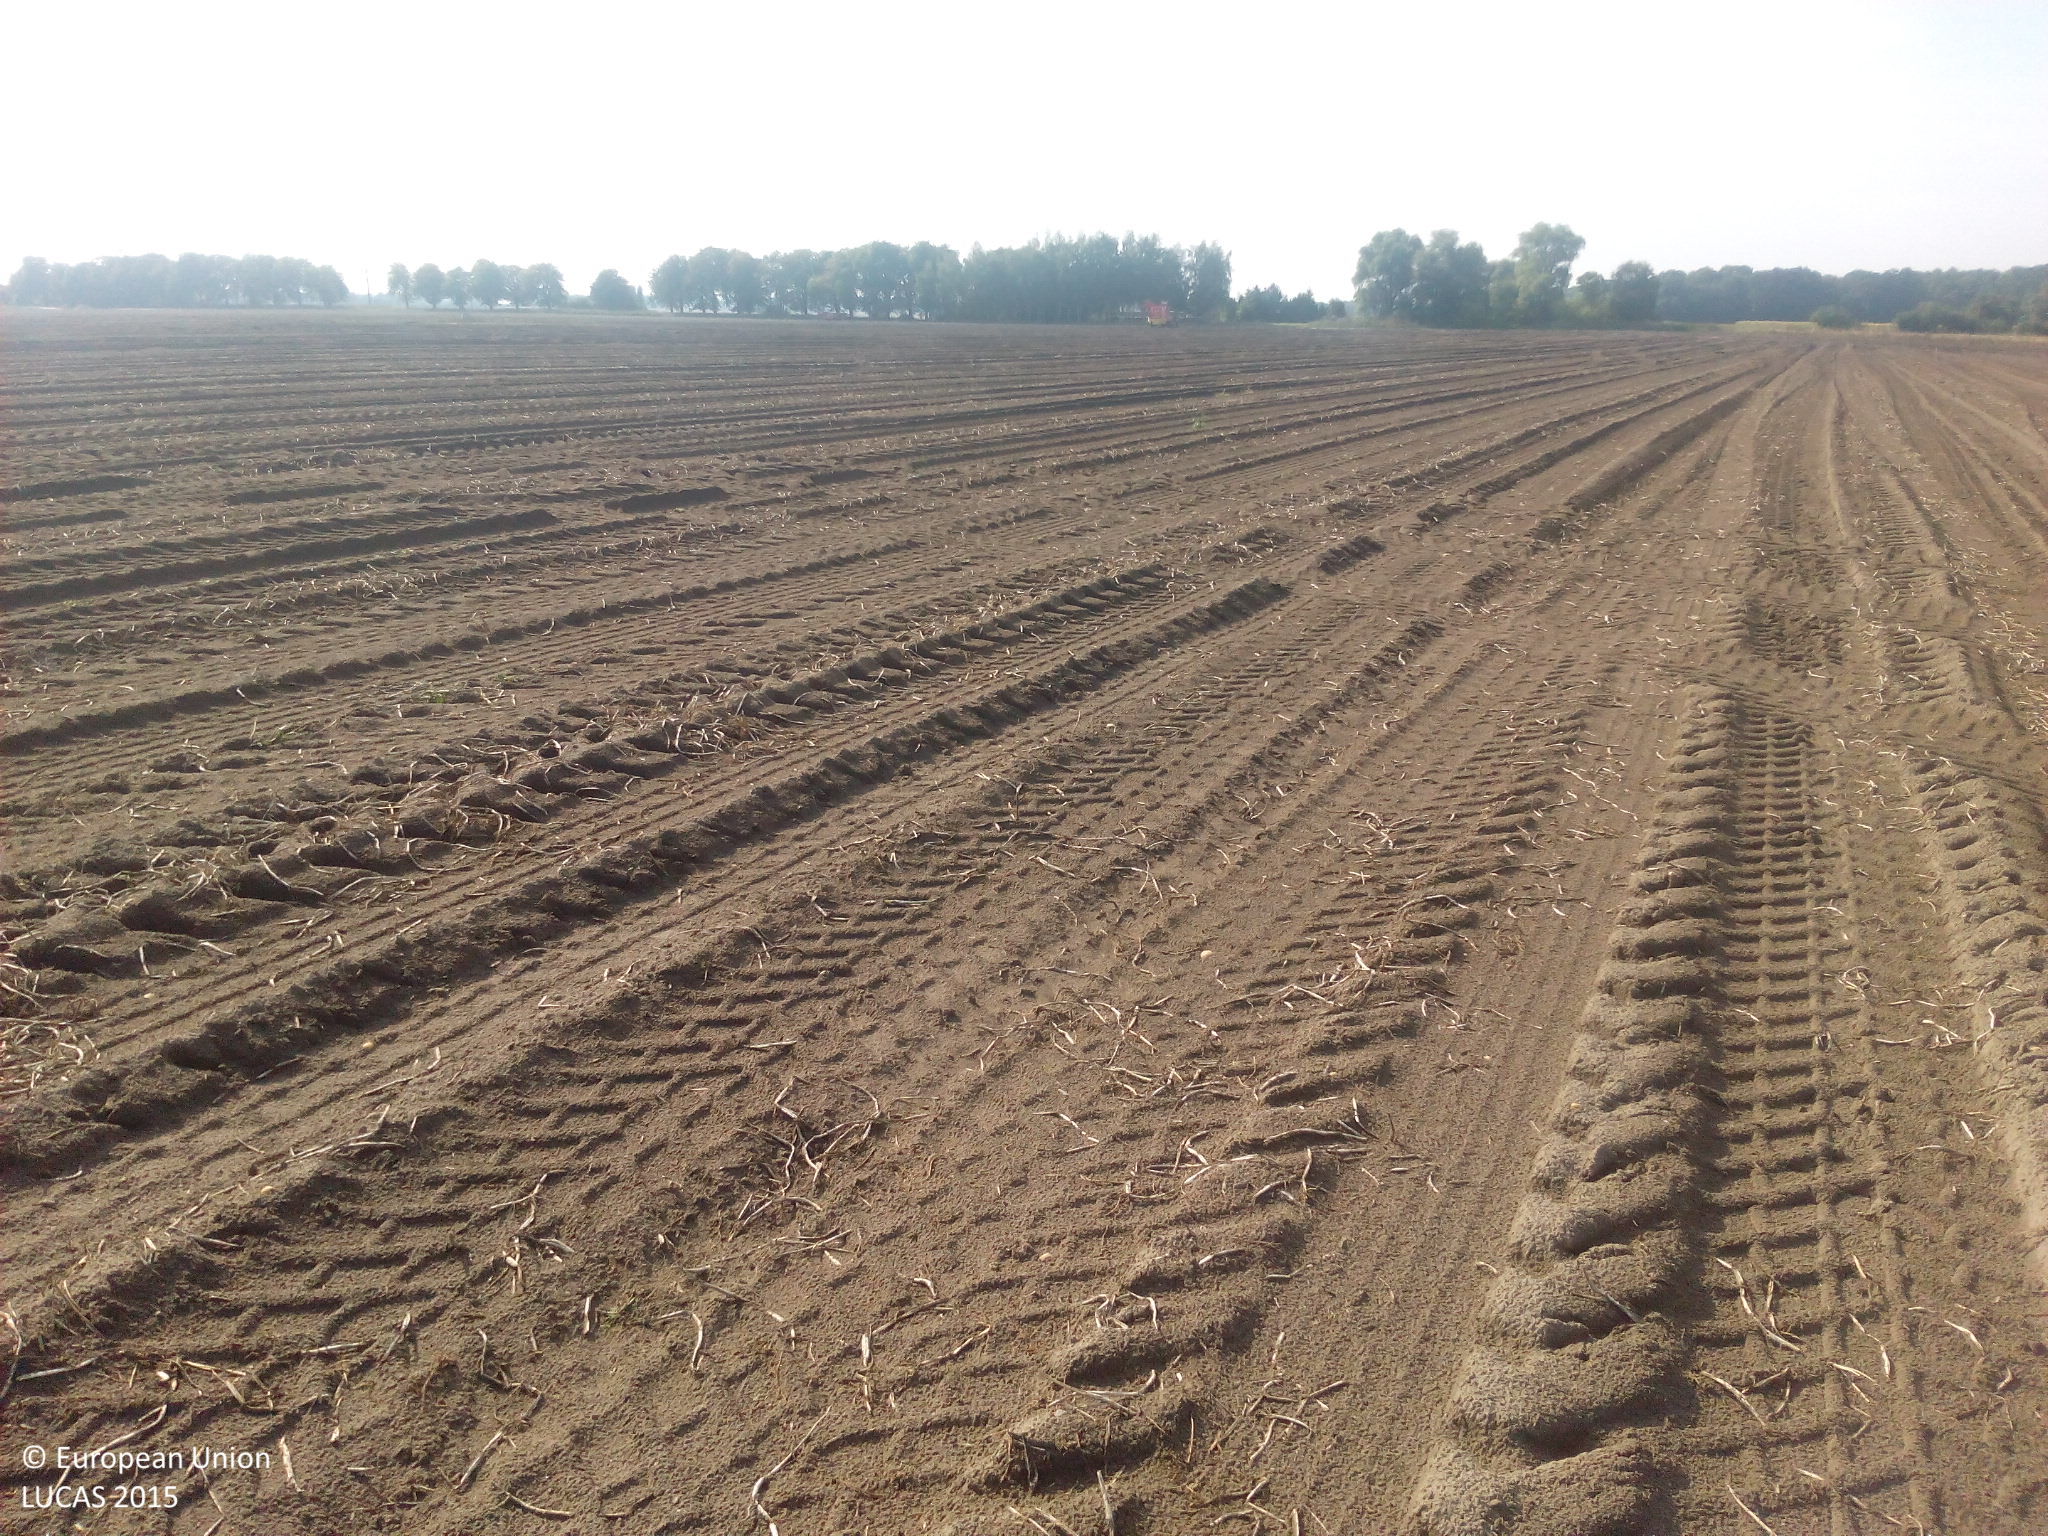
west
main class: Cropland
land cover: Potatoes
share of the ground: < 10 %
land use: Agriculture (excluding fallow land and kitchen gardens)
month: August
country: DE
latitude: 54.1809
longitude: 12.7111
